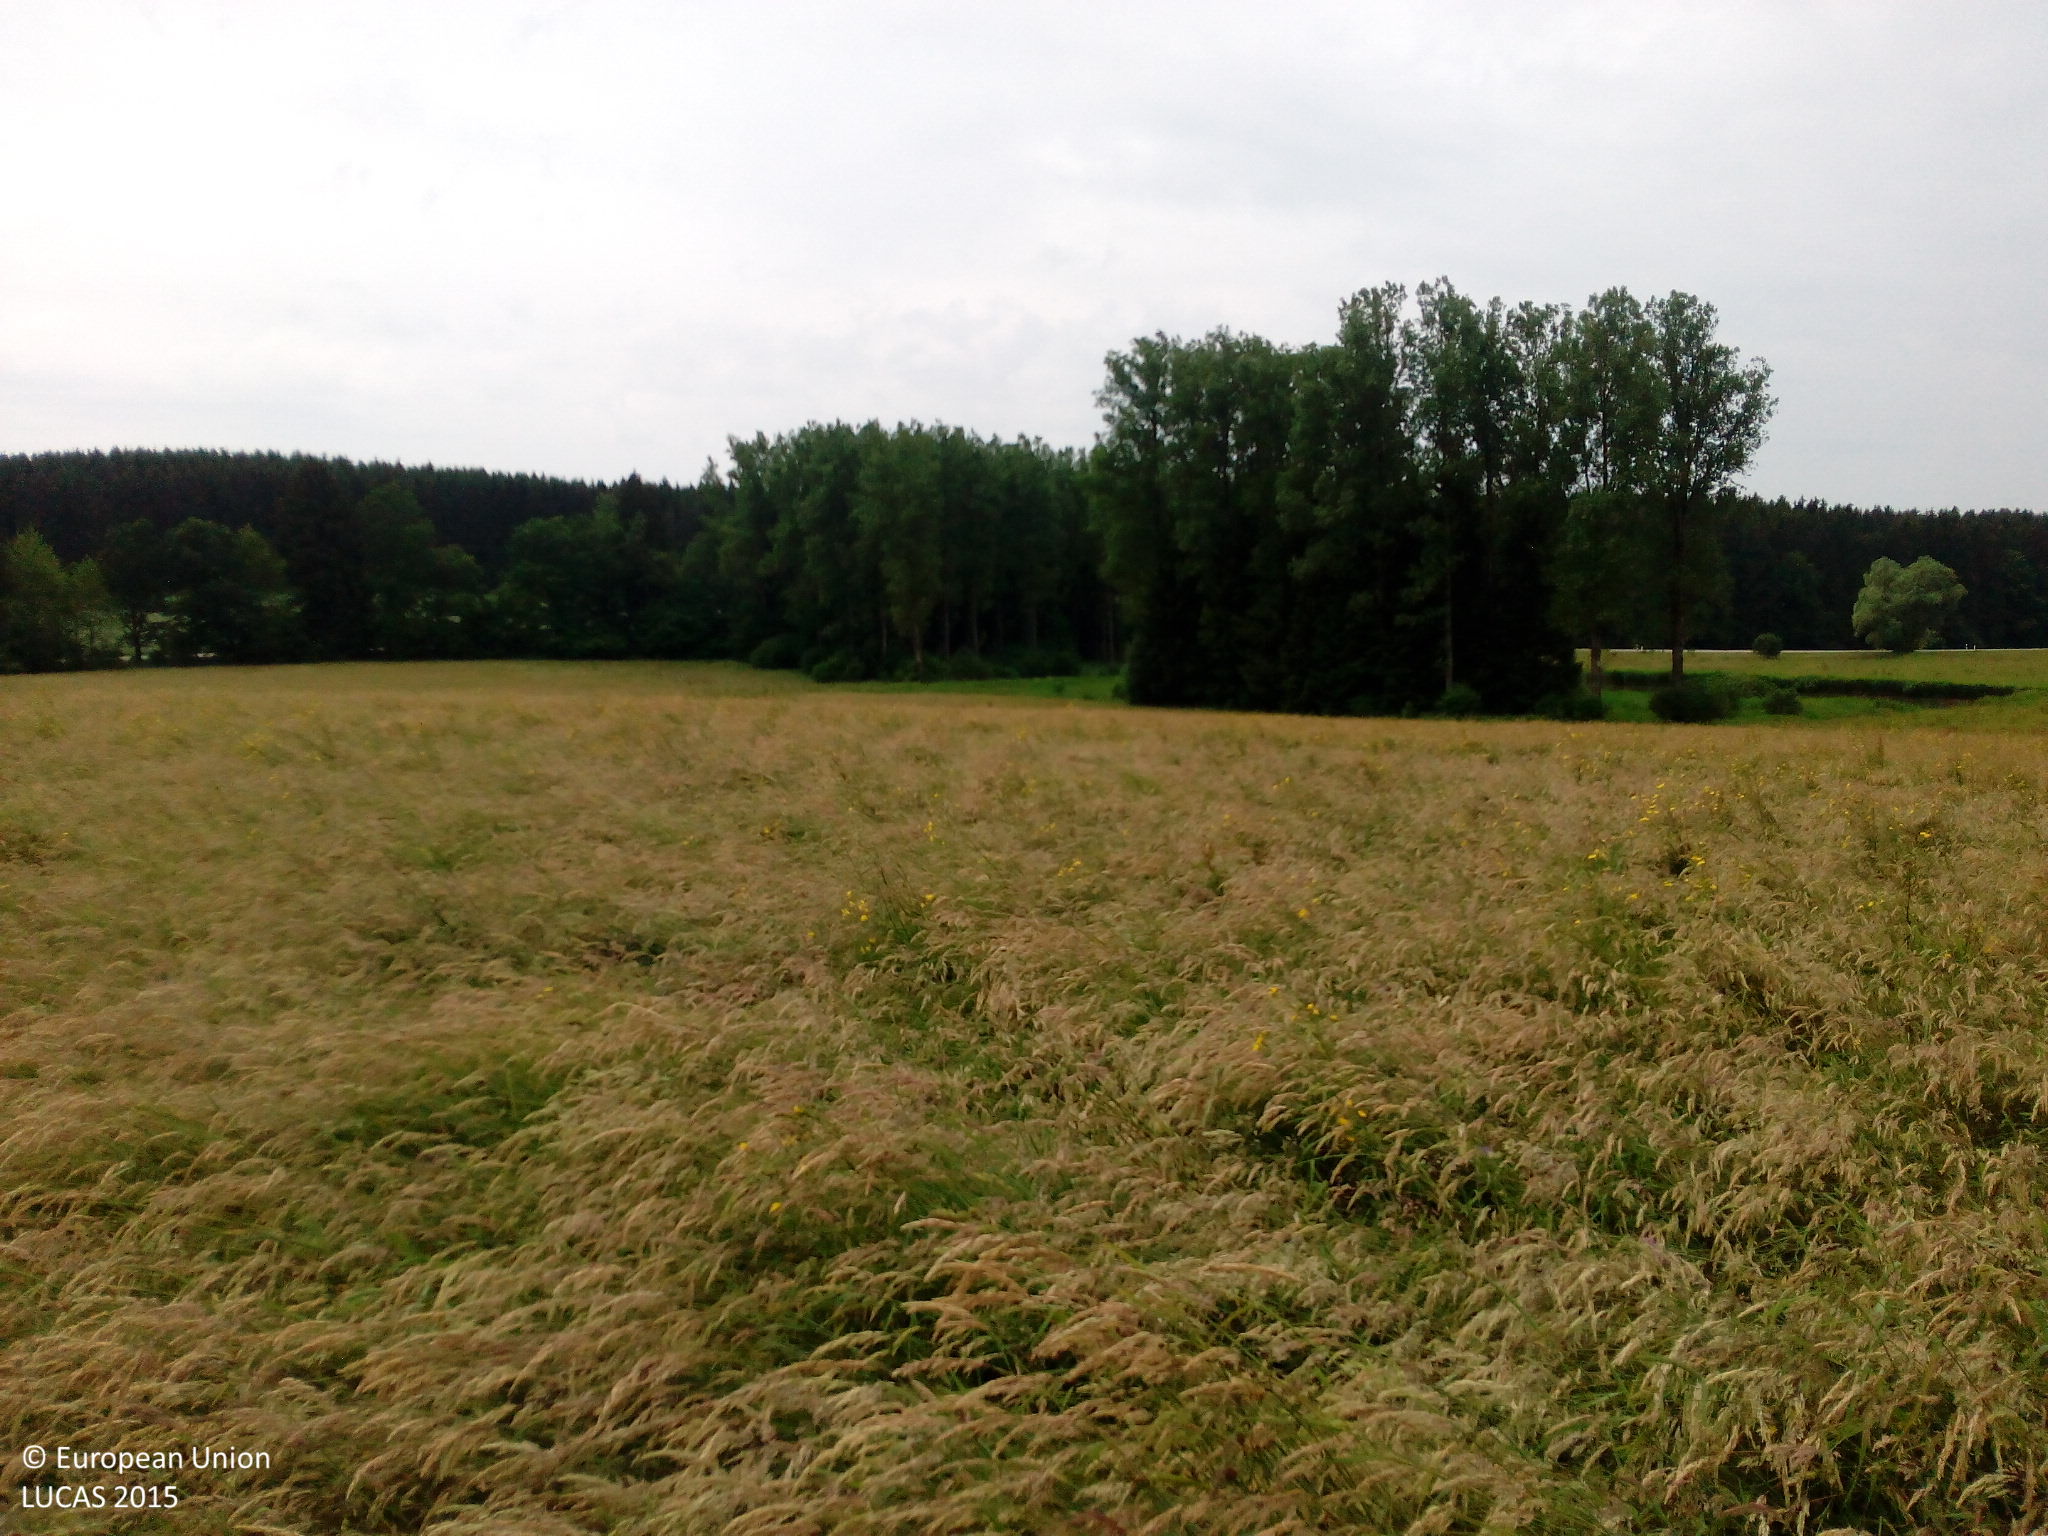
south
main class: Grassland
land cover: Grassland without tree/shrub cover
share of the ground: > 75 %
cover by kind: herbaceous plants 100 %
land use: Agriculture (excluding fallow land and kitchen gardens)
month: June
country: DE
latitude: 47.9626
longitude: 11.4053
